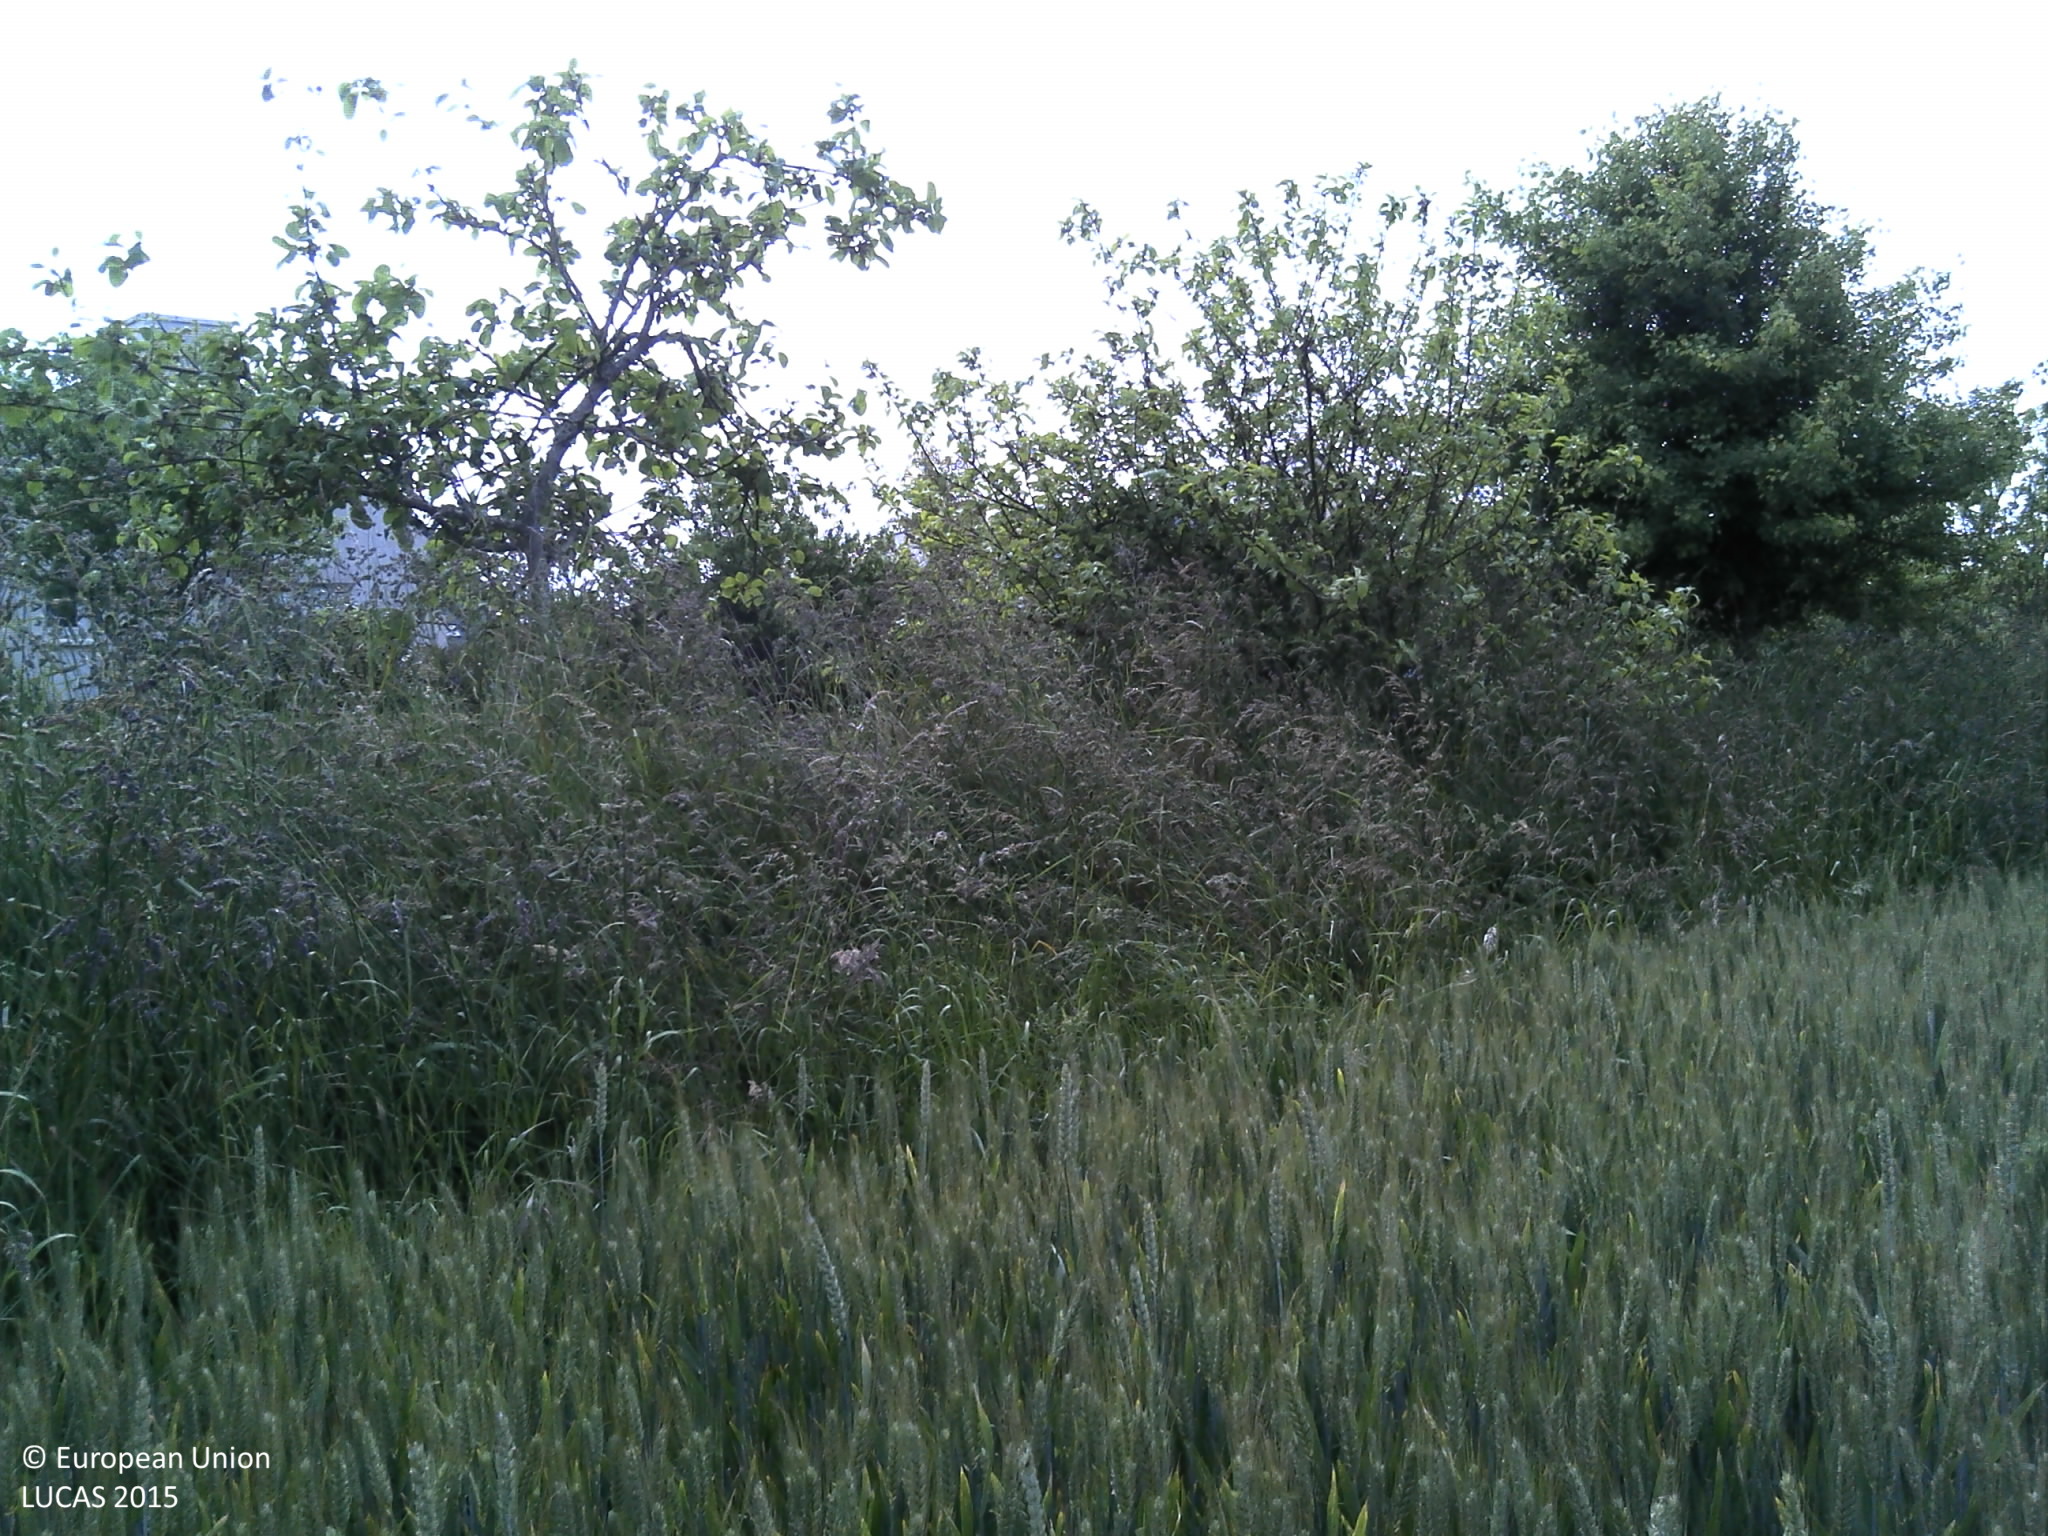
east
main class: Cropland
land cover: Common wheat
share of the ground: > 75 %
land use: Agriculture (excluding fallow land and kitchen gardens)
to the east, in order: Common wheat; Grass margins; Lines of trees; Ditches and canals; Grass margins; Paved roads, cycling and walking lanes; Grass margins; Ditches and canals; Lines of trees; Artificial constructions in urban areas
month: June
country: FR
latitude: 47.7810
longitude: -3.5699
